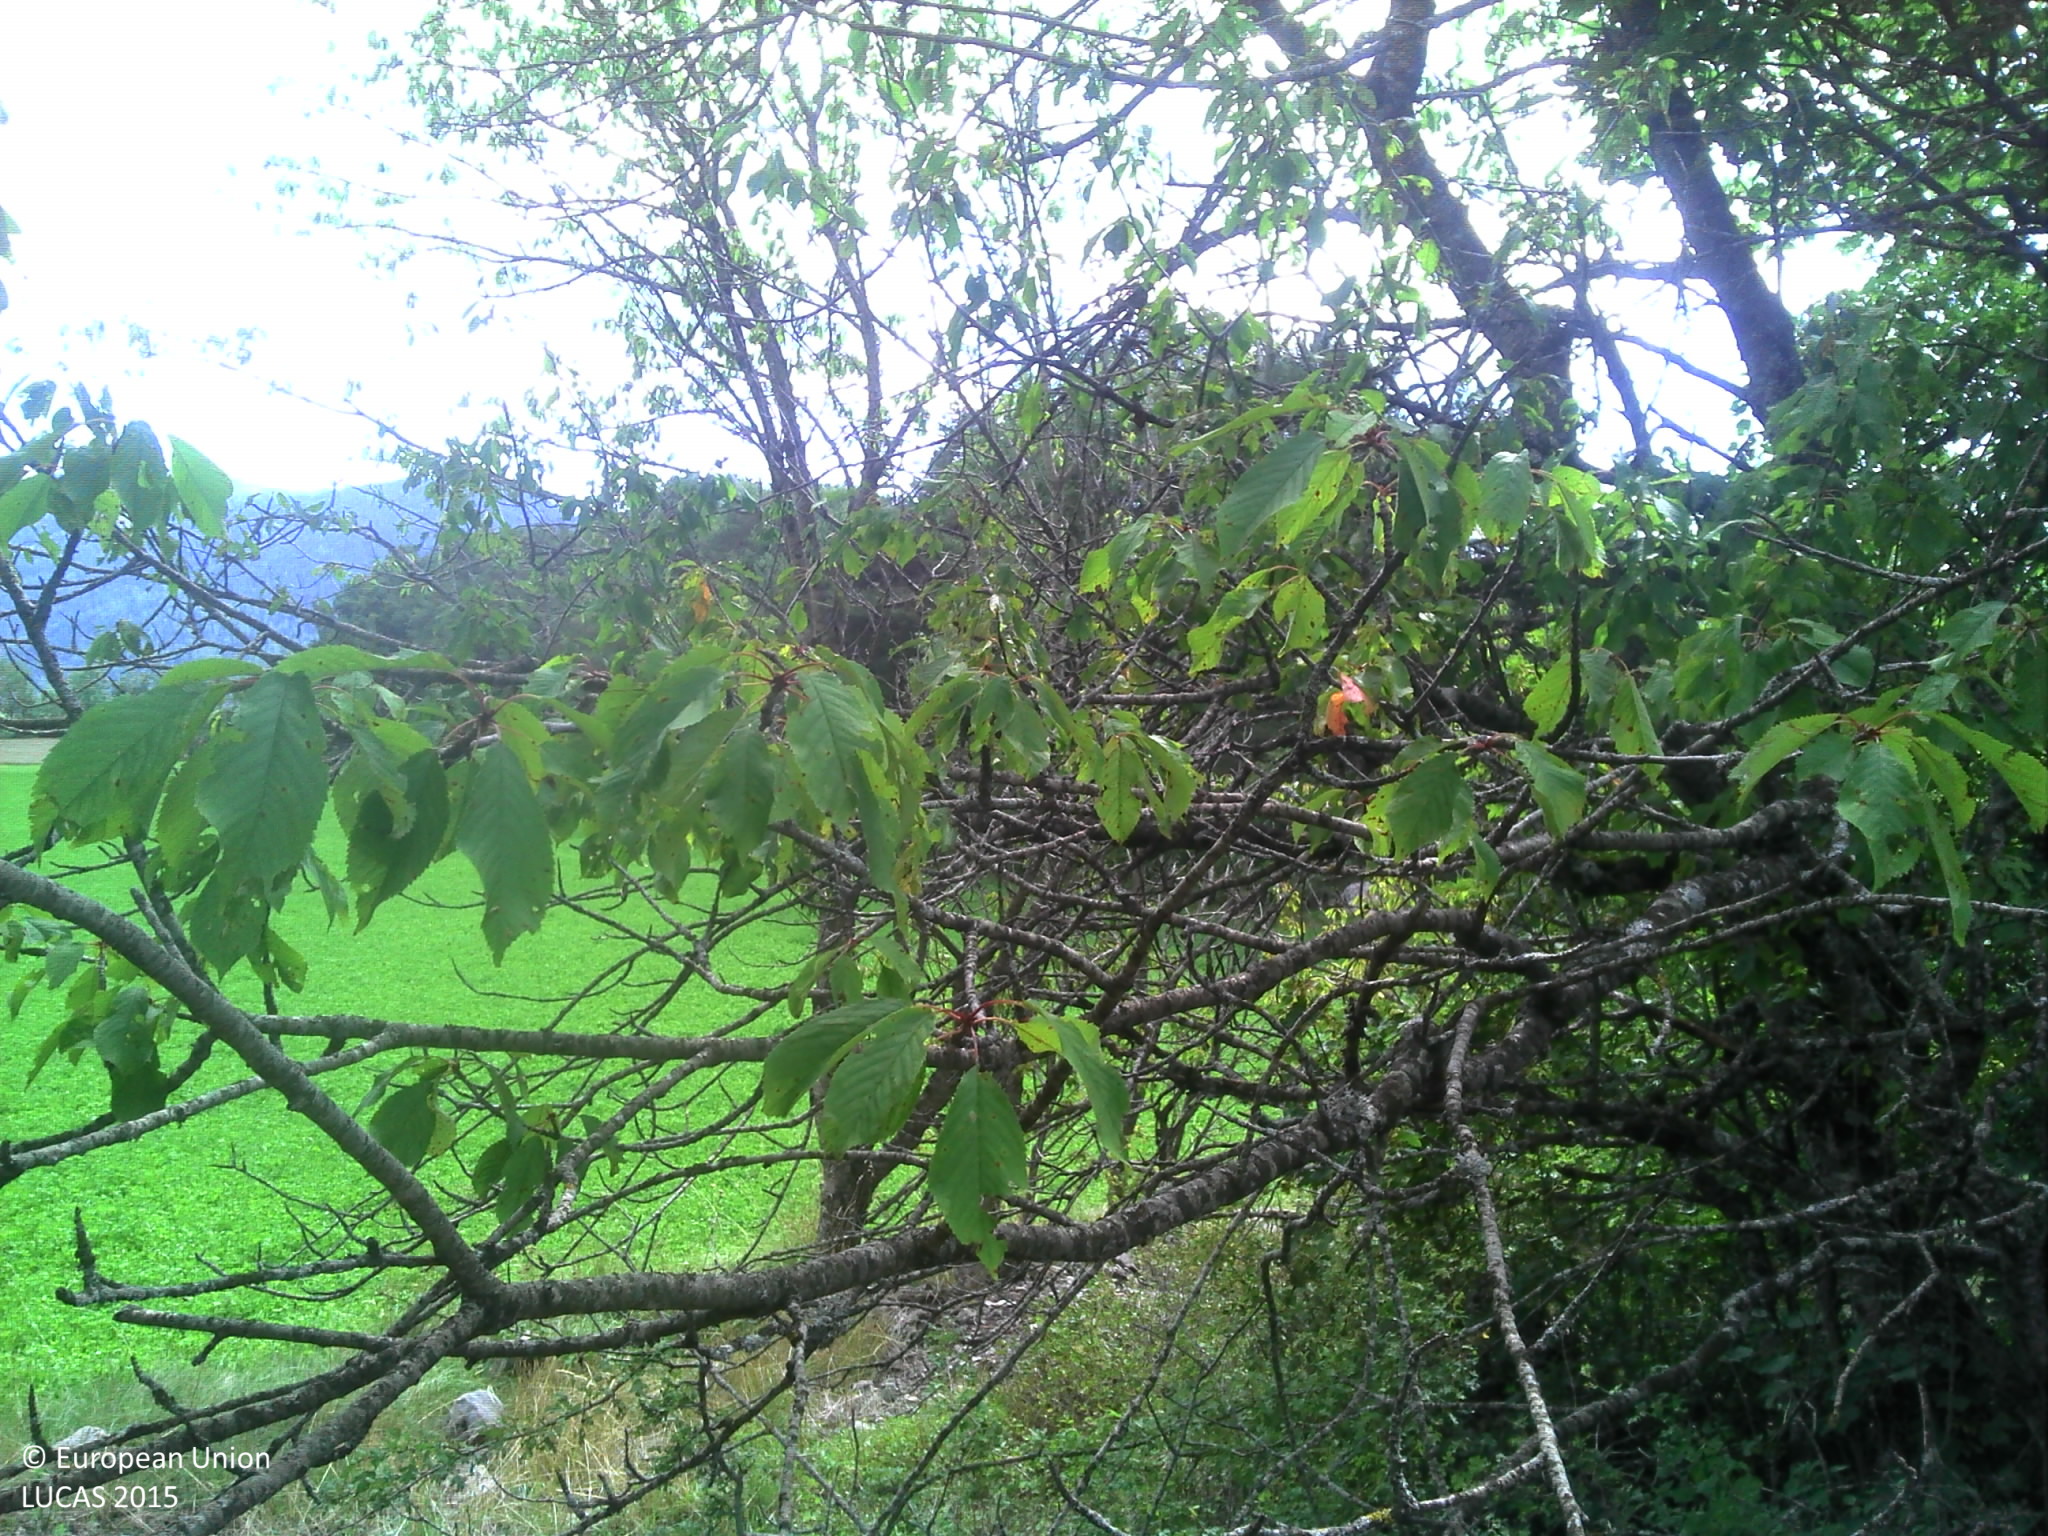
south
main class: Woodland
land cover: Broadleaved woodland
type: thermophilous deciduous forest
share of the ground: > 75 %
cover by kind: broadleaved forest trees 60 %, herbaceous plants 25 %, unconsolidated bare surface 15 %
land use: Forestry
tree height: > 5 m
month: August
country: FR
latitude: 44.3597
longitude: 6.3807
